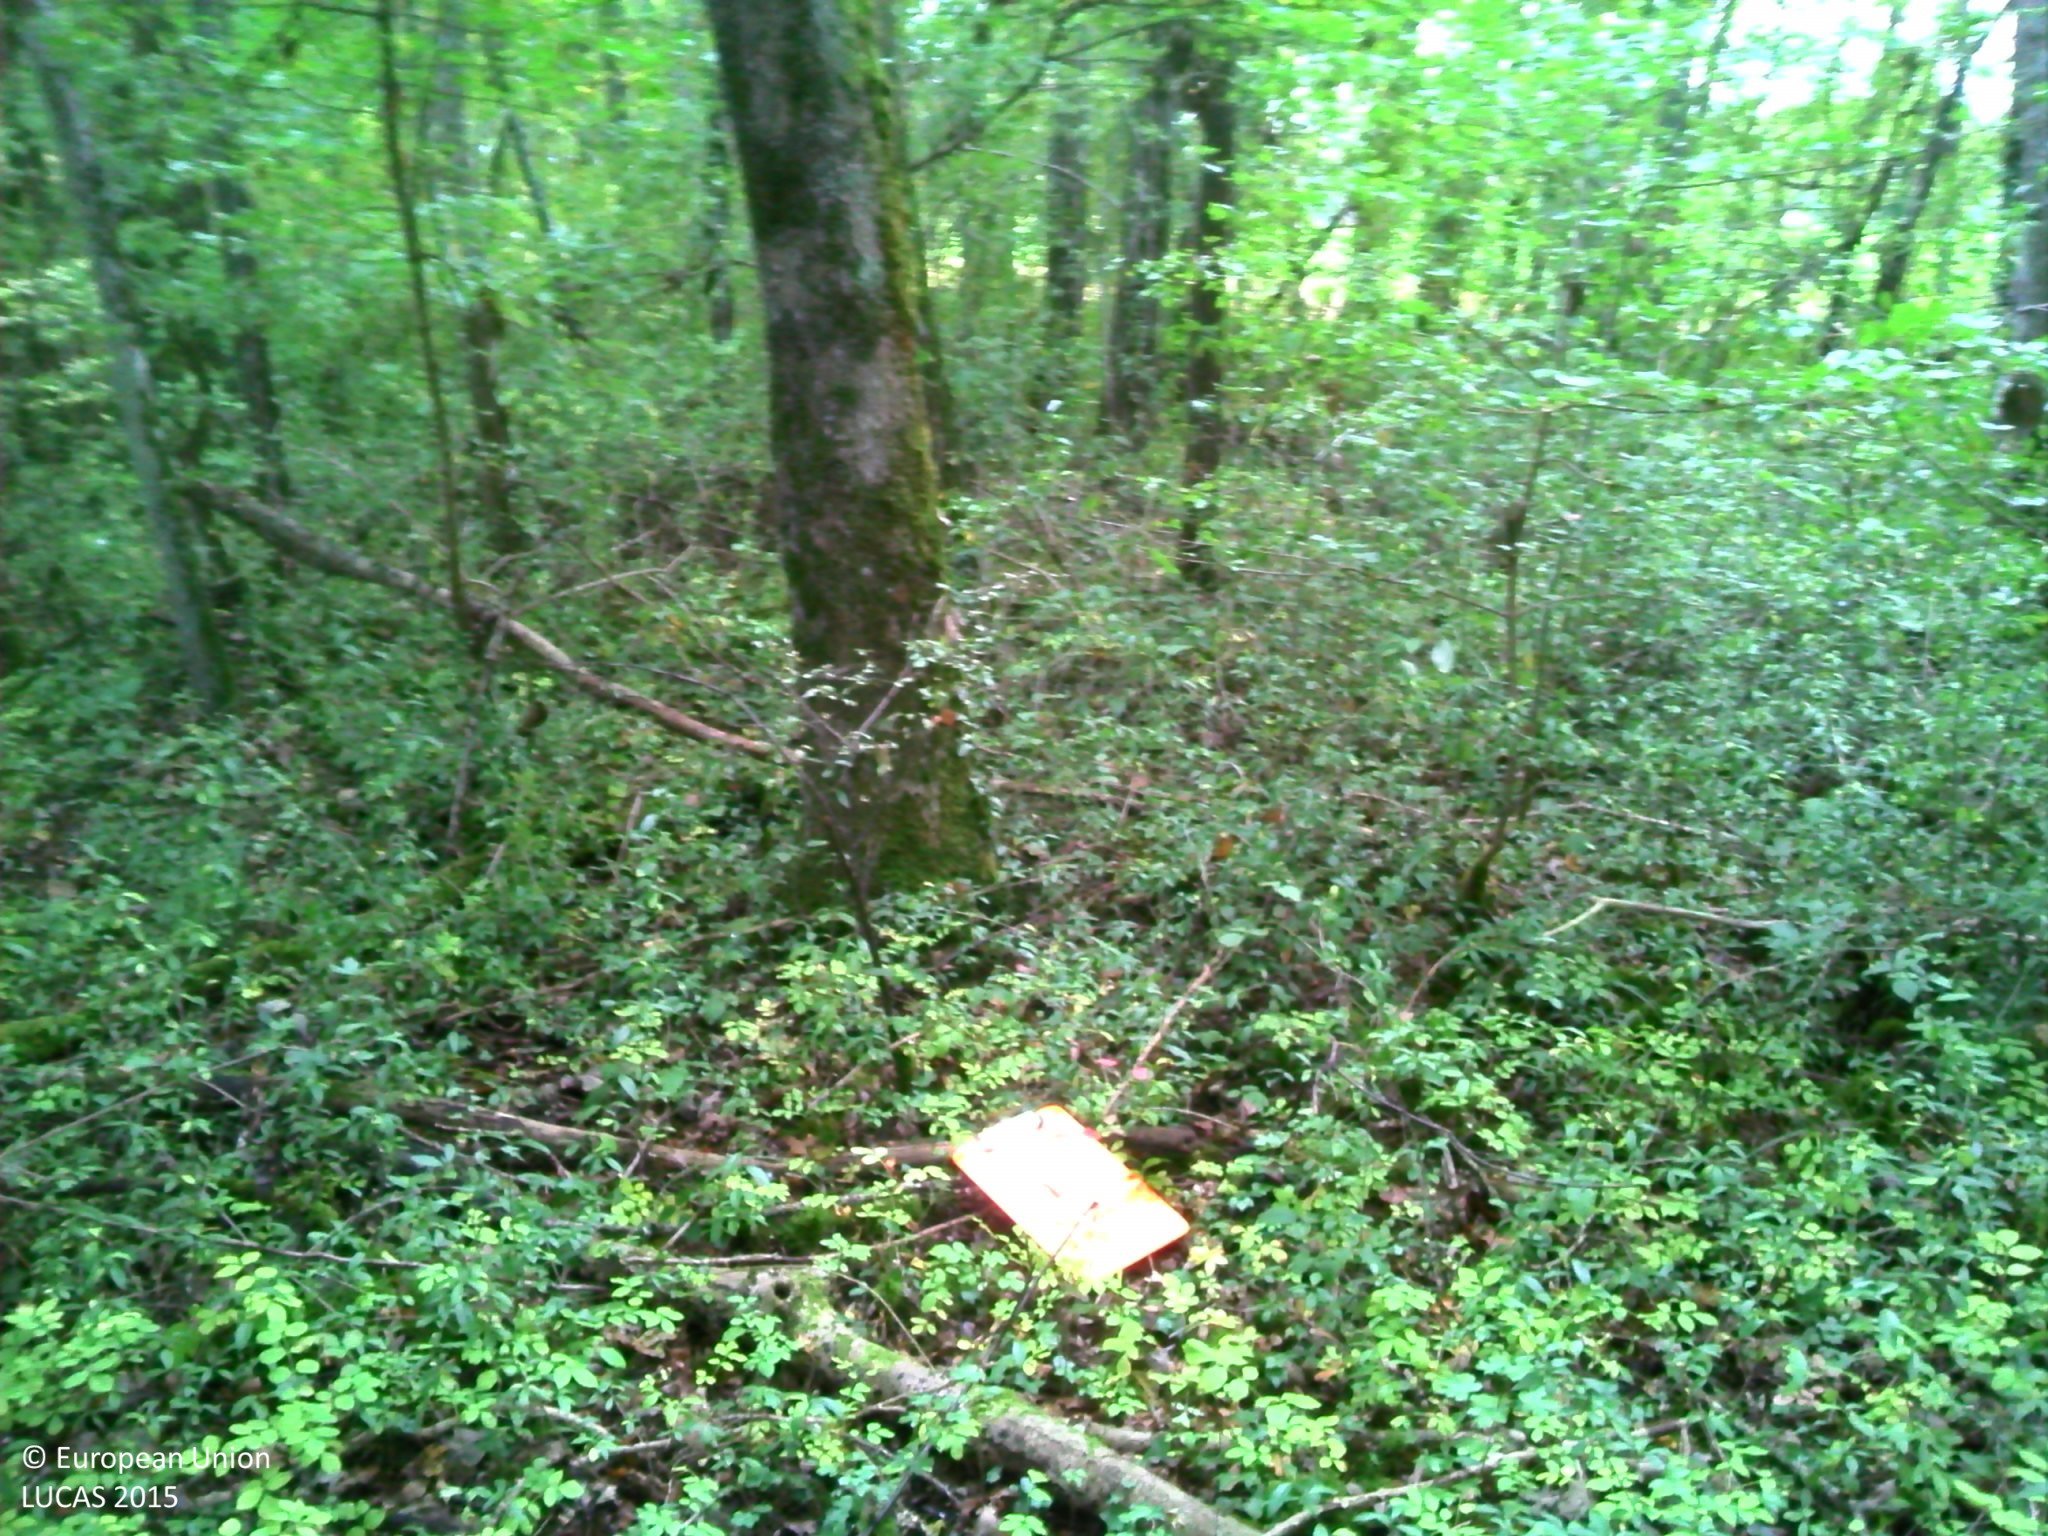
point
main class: Woodland
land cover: Broadleaved woodland
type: mesophytic deciduous forest
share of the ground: > 75 %
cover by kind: broadleaved forest trees 100 %
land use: Semi-natural and natural areas not in use
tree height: > 5 m
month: October
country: FR
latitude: 47.1724
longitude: 5.0004
